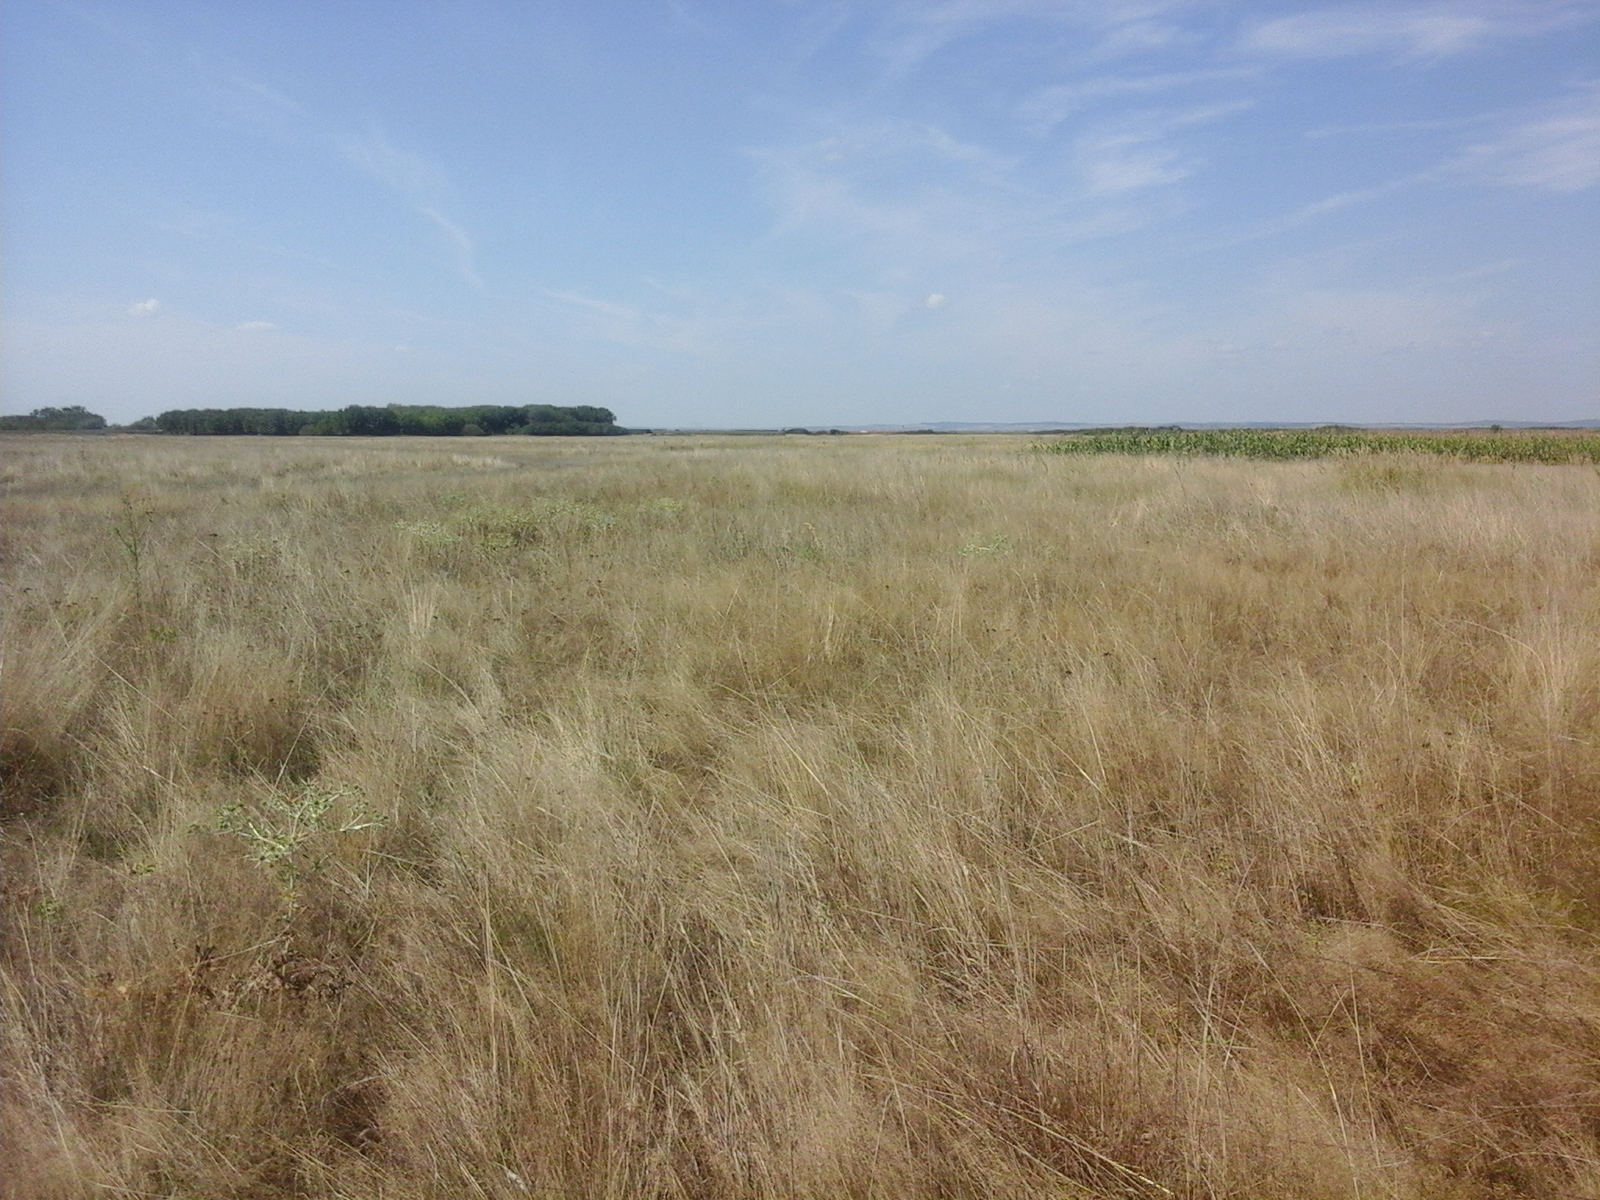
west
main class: Grassland
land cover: Spontaneously vegetated surfaces
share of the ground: > 75 %
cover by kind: herbaceous plants 100 %
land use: Agriculture (excluding fallow land and kitchen gardens)
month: August
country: RO
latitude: 45.6969
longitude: 21.7878
